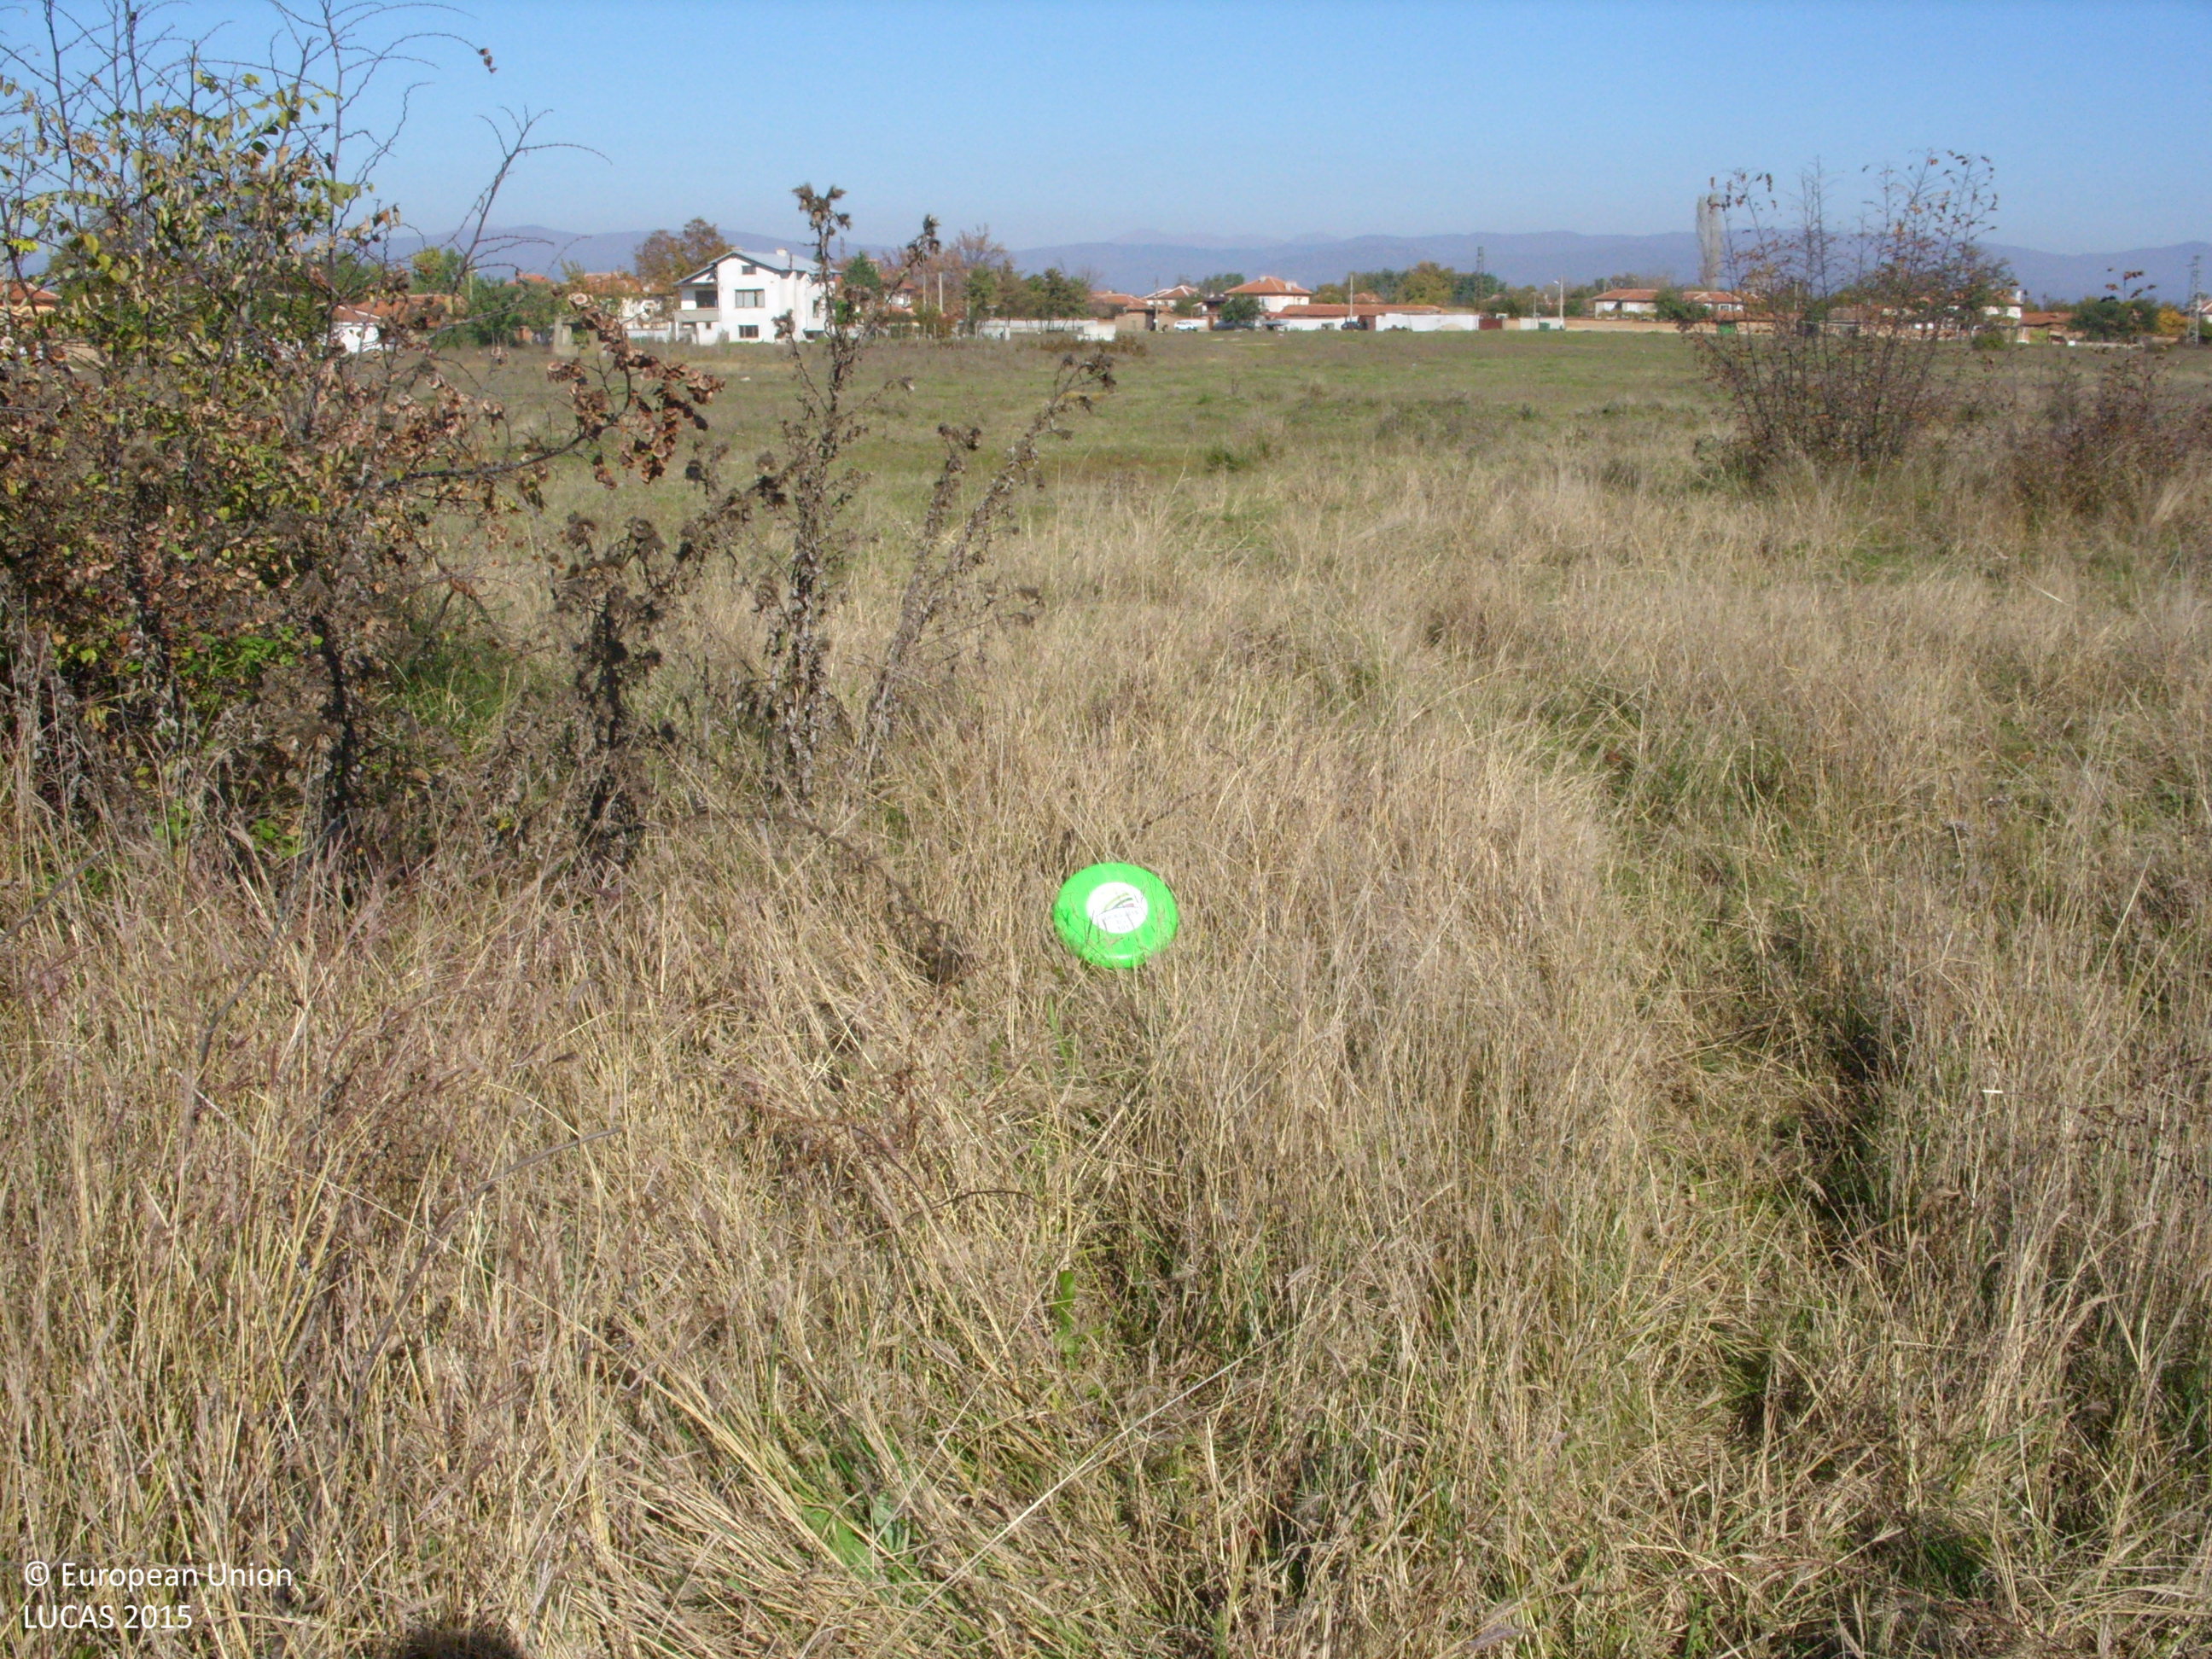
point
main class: Grassland
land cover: Grassland with sparse tree/shrub cover
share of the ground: > 75 %
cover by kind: herbaceous plants 85 %, shrubs 10 %, broadleaved forest trees 5 %
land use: Agriculture (excluding fallow land and kitchen gardens)
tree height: > 5 m
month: November
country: BG
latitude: 42.3366
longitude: 24.9989
